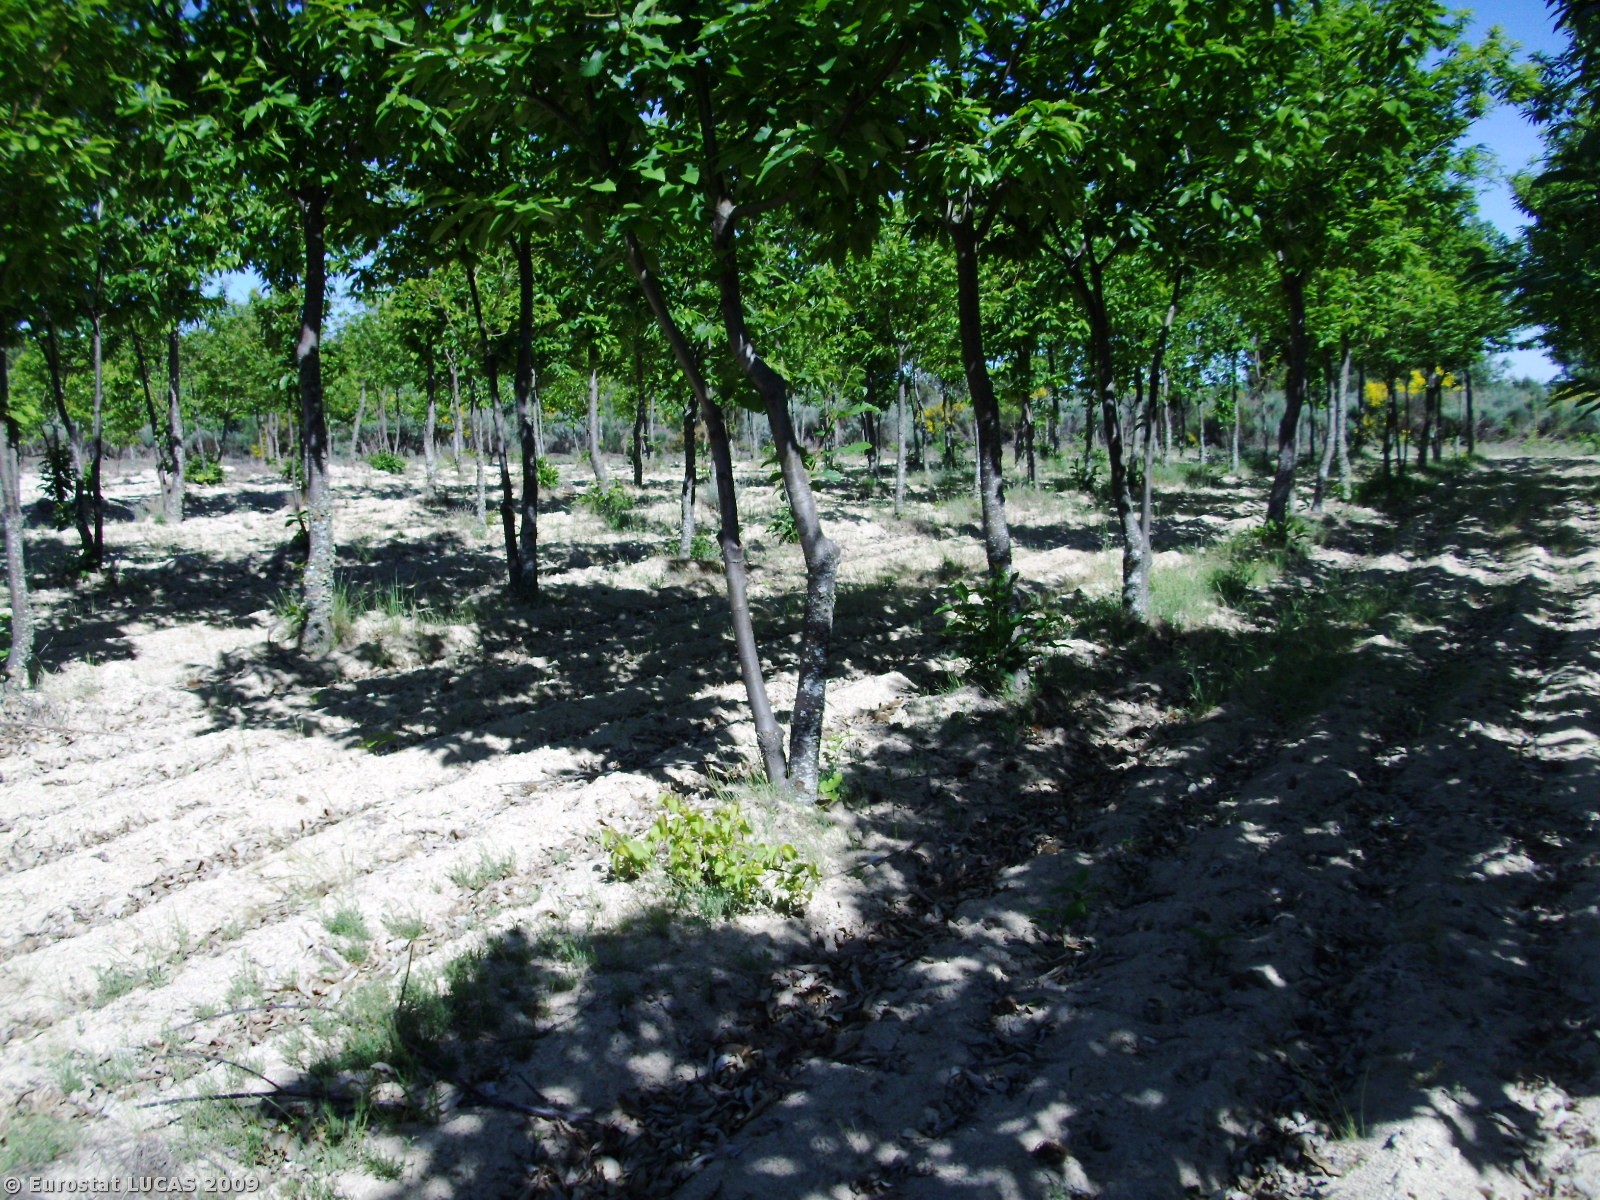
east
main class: Woodland
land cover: Broadleaved woodland
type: mesophytic deciduous forest
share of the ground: 50 - 75 %
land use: Forestry
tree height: > 5 m
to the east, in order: Broadleaved woodland; Apple fruit; Dry stone walls; Tracks; Dry stone walls; Broadleaved woodland; Shruby margins; Spontaneously vegetated surfaces
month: May
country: PT
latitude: 40.8527
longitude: -7.3244
